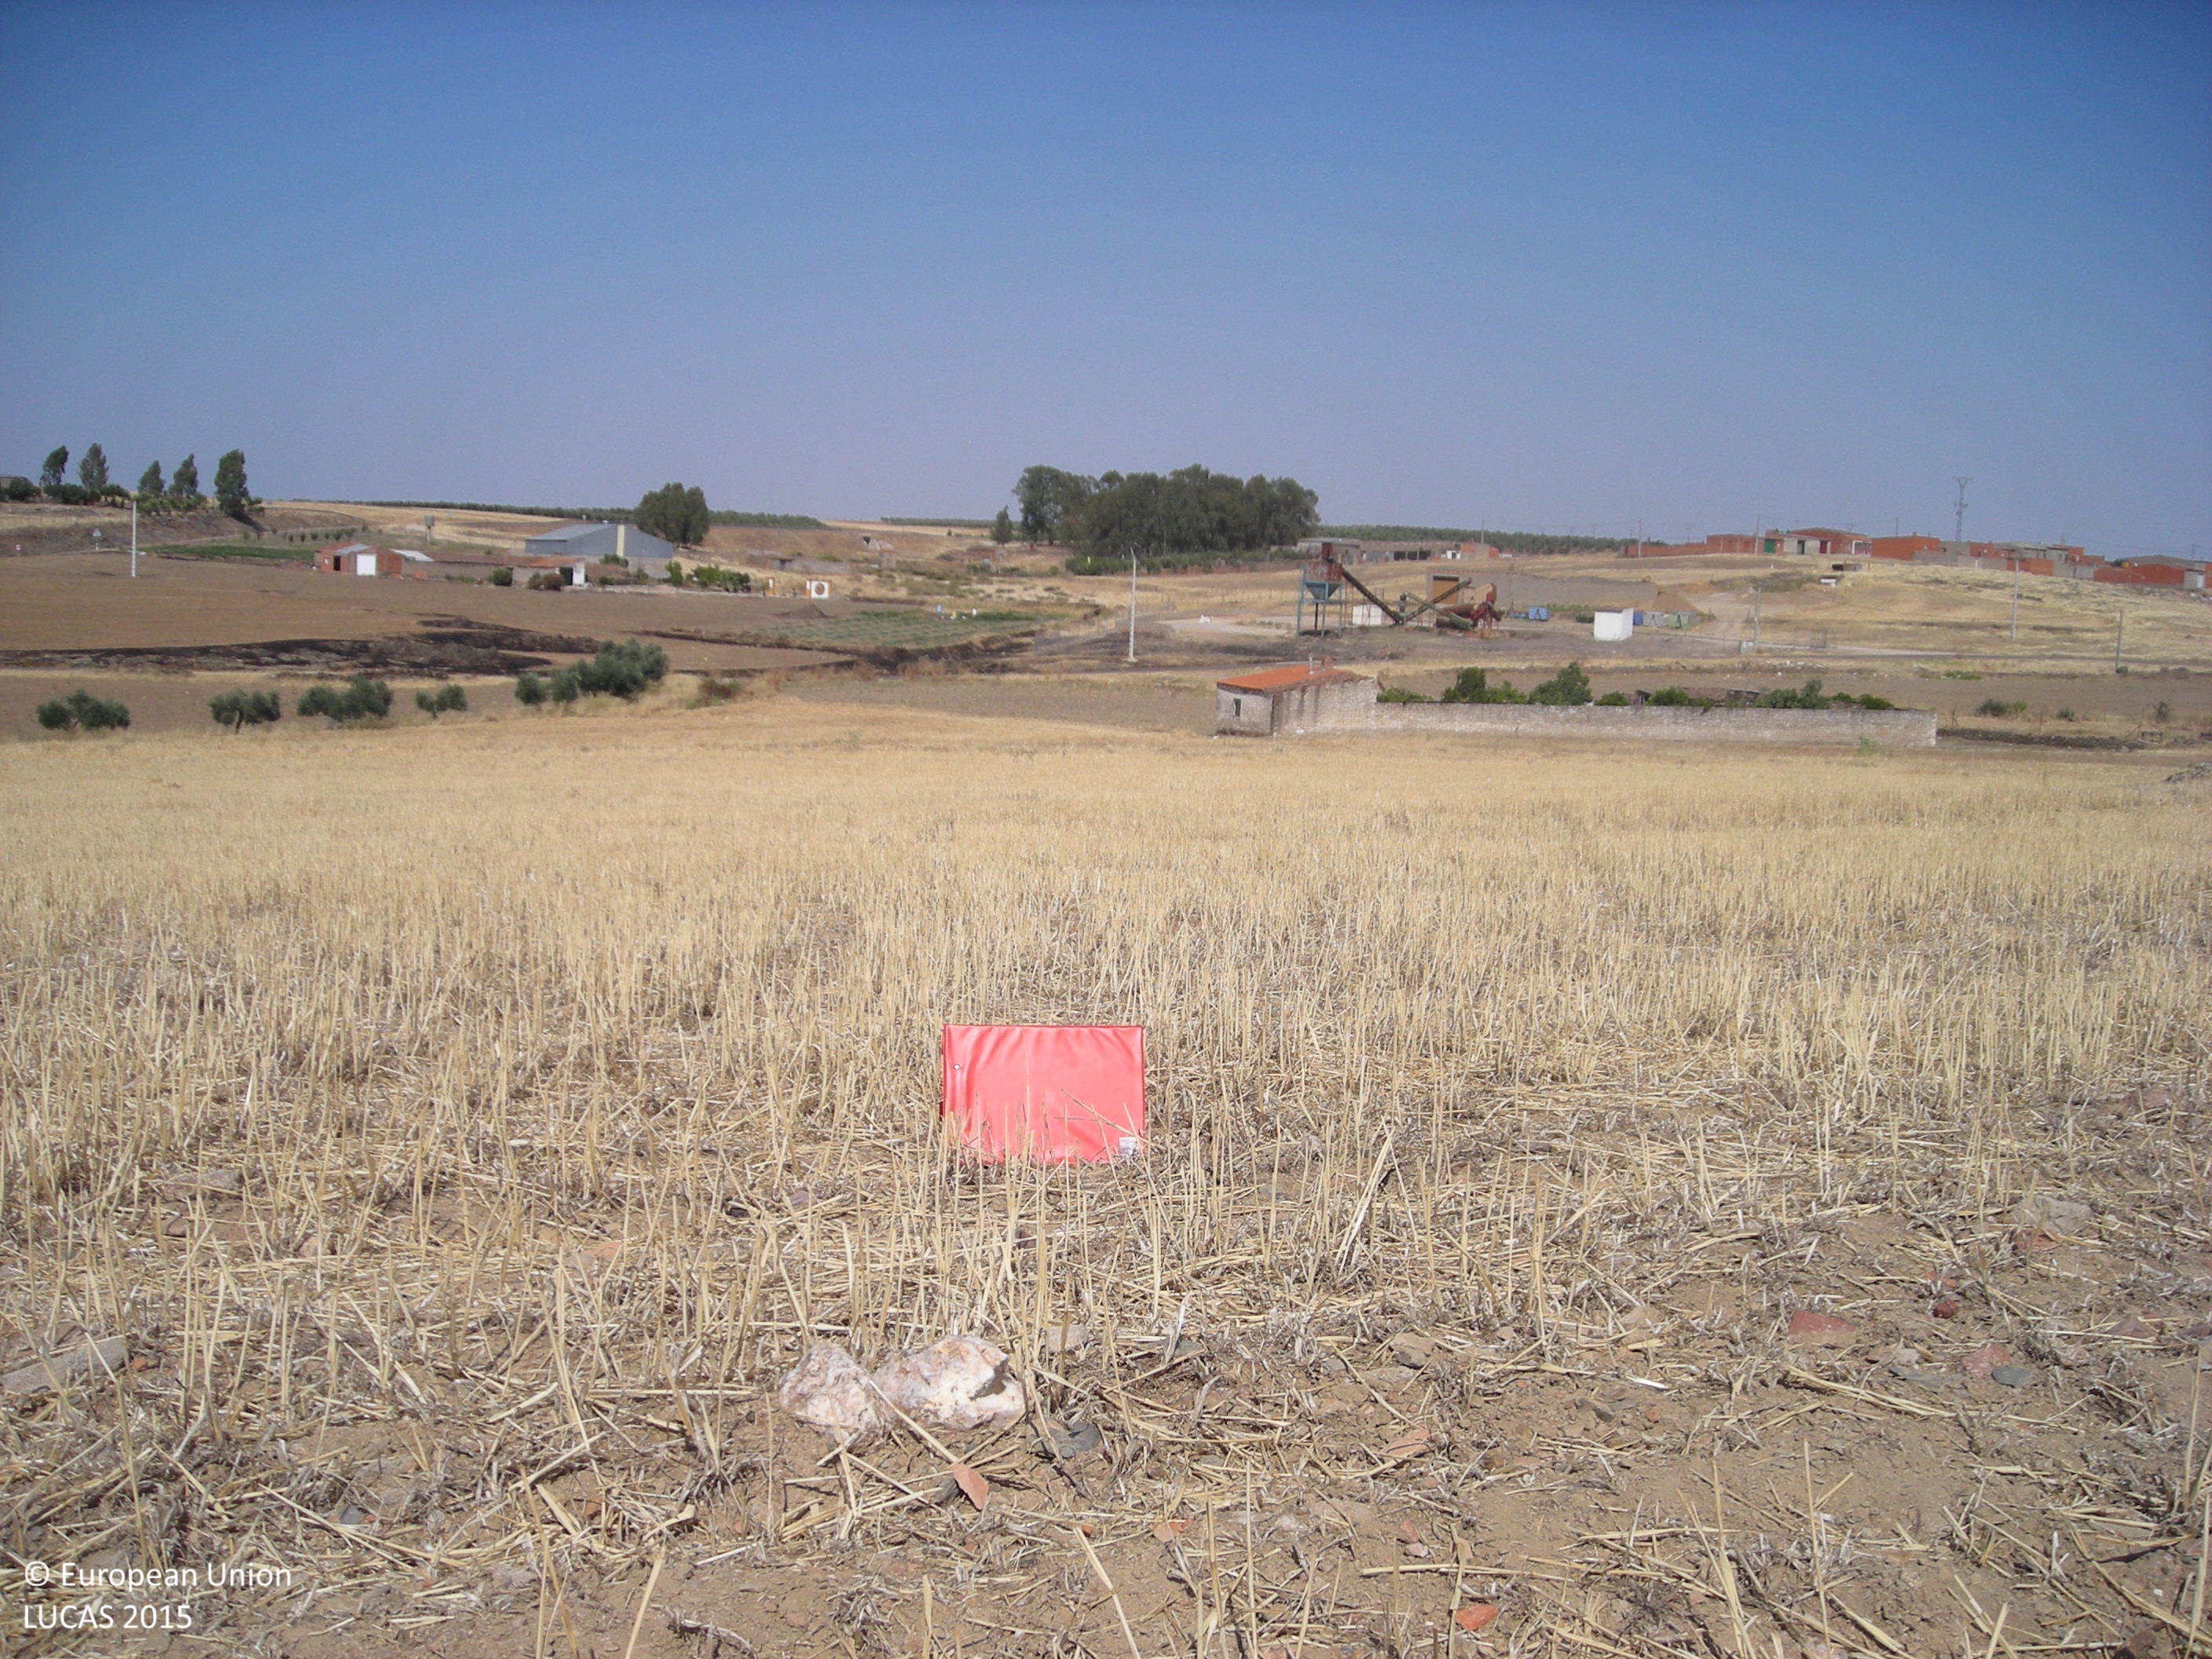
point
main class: Cropland
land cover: Common wheat
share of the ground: > 75 %
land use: Agriculture (excluding fallow land and kitchen gardens)
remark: Harvested field
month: July
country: ES
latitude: 38.9250
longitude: -5.6748
